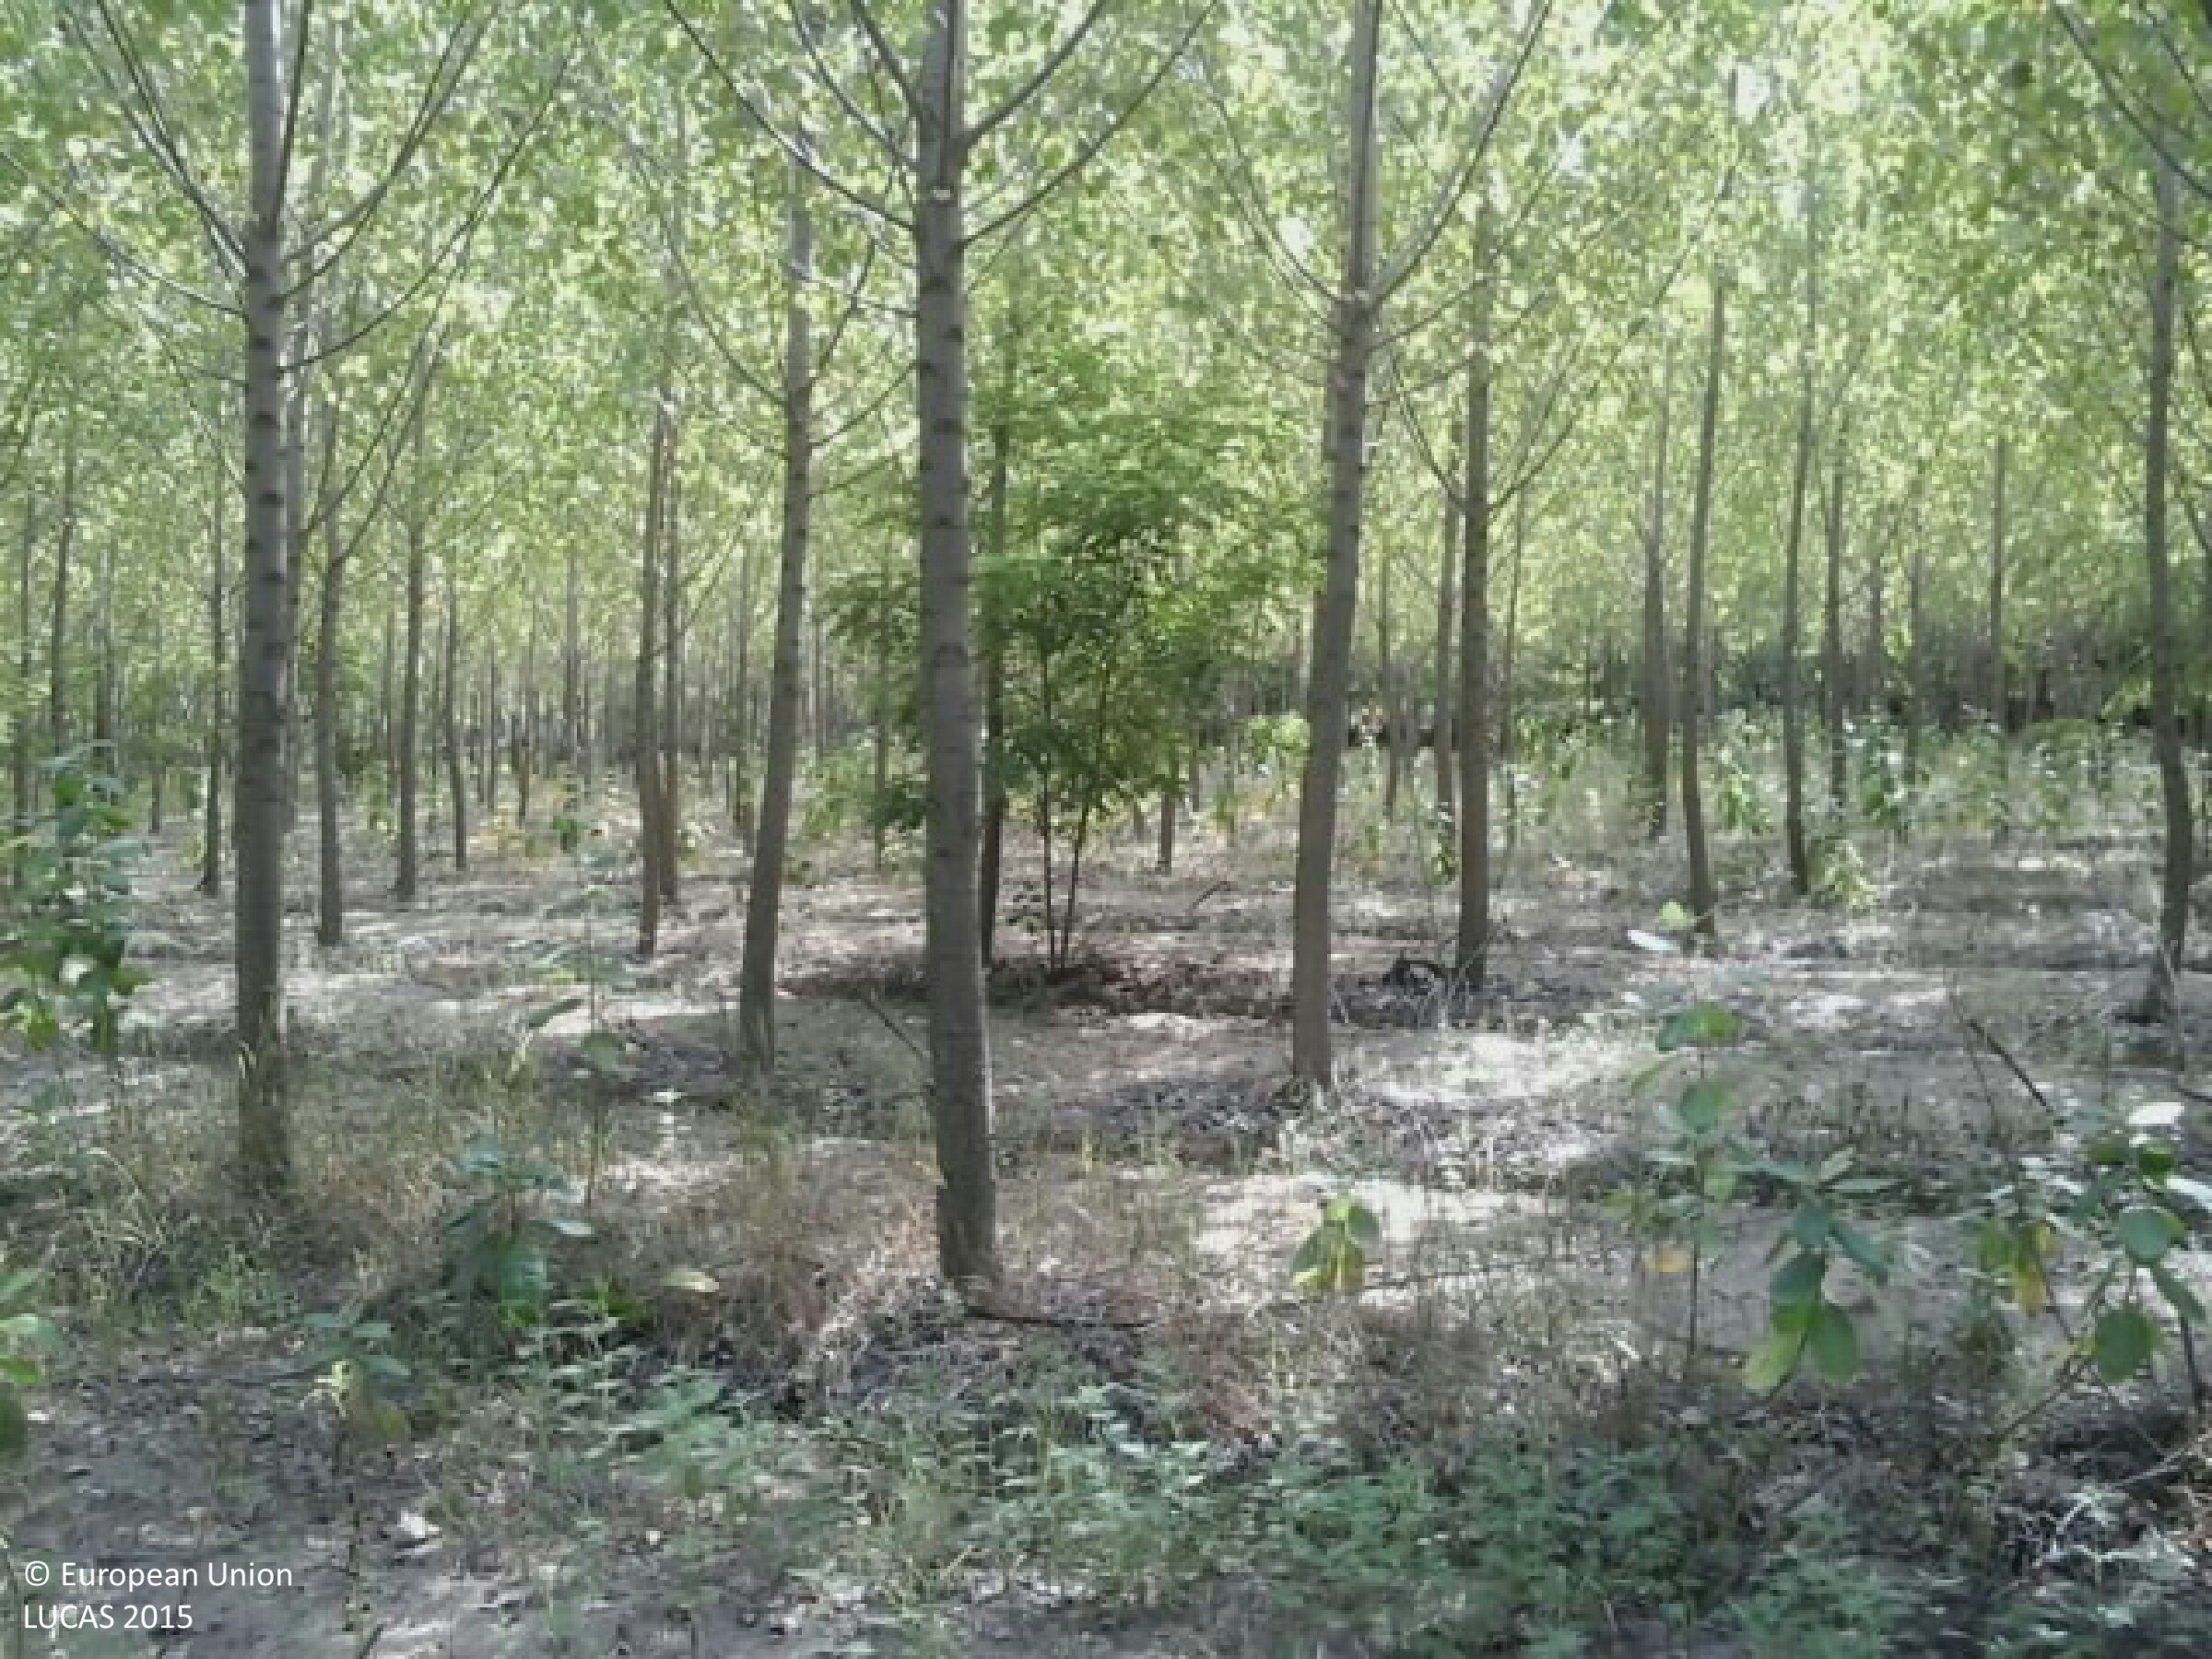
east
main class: Woodland
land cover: Broadleaved woodland
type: non-riverine alder, birch or aspen forest
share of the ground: 50 - 75 %
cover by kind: broadleaved forest trees 85 %, unconsolidated bare surface 15 %
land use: Forestry
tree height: > 5 m
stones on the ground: < 10 %
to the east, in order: Broadleaved woodland; Grassland with sparse tree/shrub cover; Tracks; Lines of trees; Electric lines; Lucerne
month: August
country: HU
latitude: 47.0782
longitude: 19.8080
